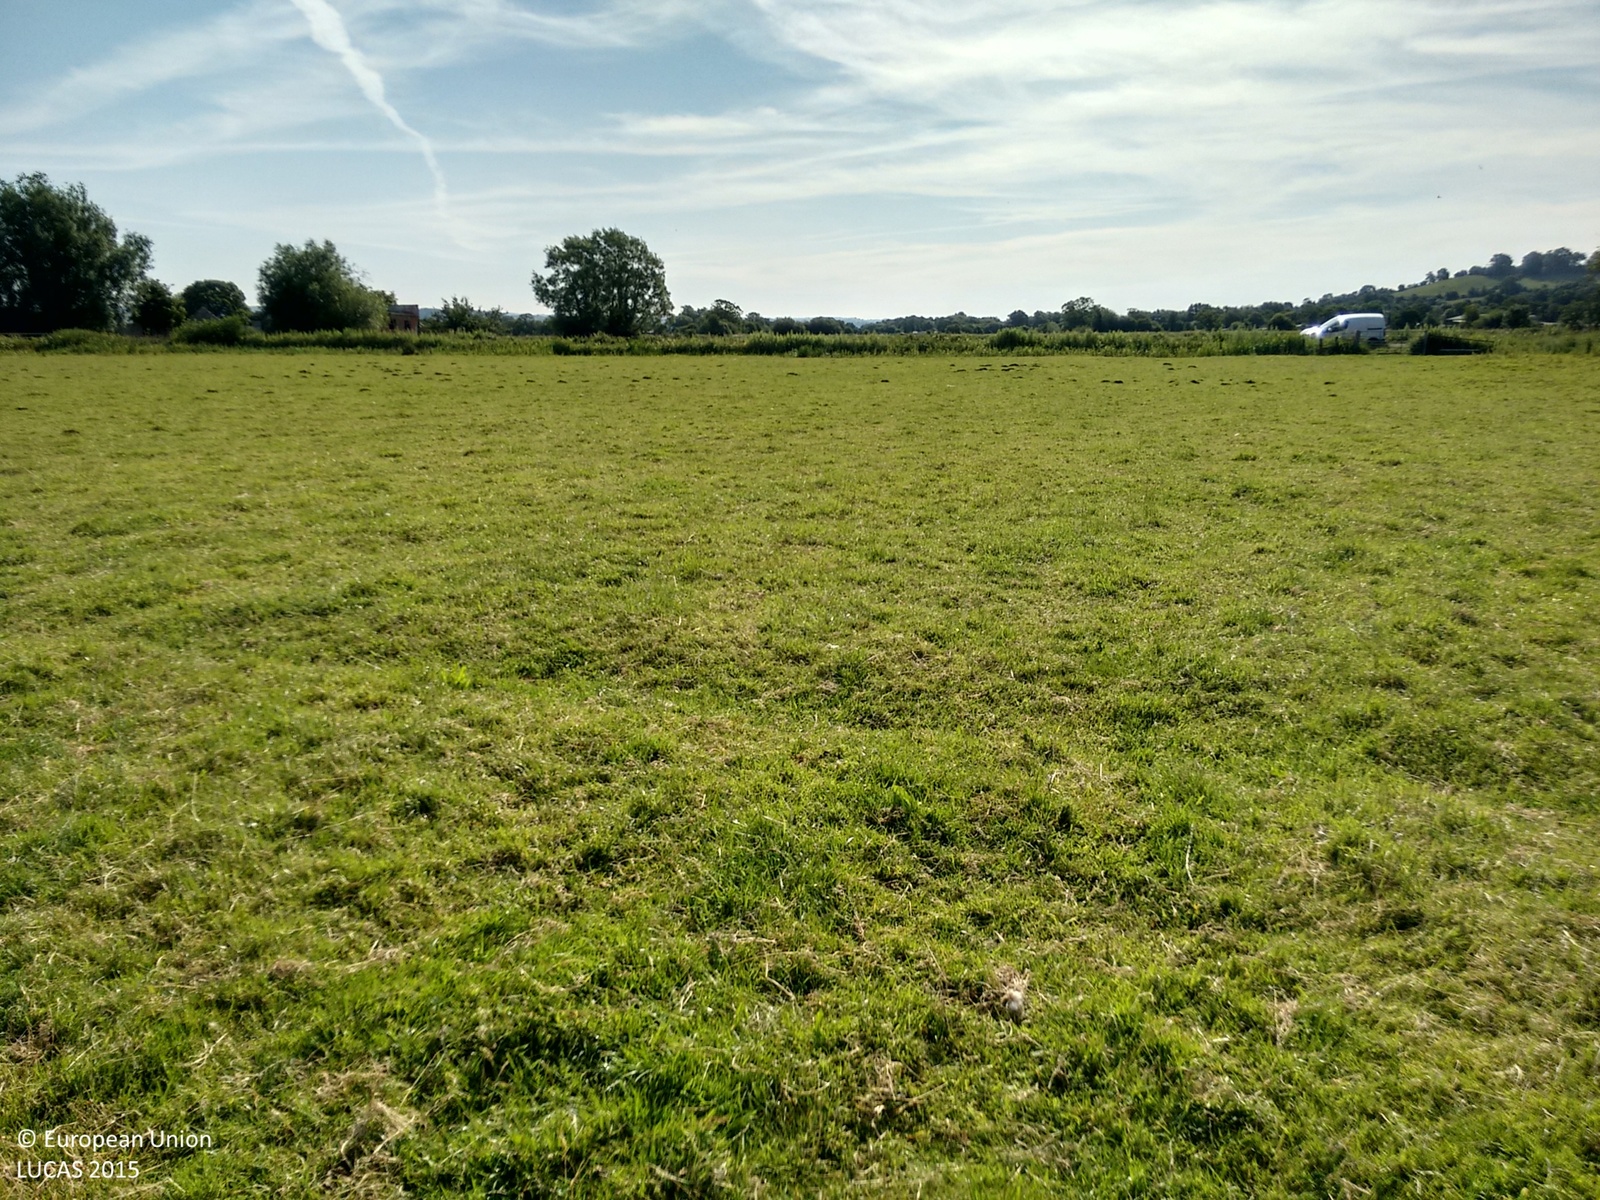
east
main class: Grassland
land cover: Grassland without tree/shrub cover
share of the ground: > 75 %
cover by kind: herbaceous plants 100 %
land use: Agriculture (excluding fallow land and kitchen gardens)
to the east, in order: Grassland without tree/shrub cover; Ditches and canals; Grass margins; Paved roads, cycling and walking lanes; Shruby margins; Ditches and canals; Grassland without tree/shrub cover
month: July
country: GB
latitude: 51.1610
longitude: -2.7251
